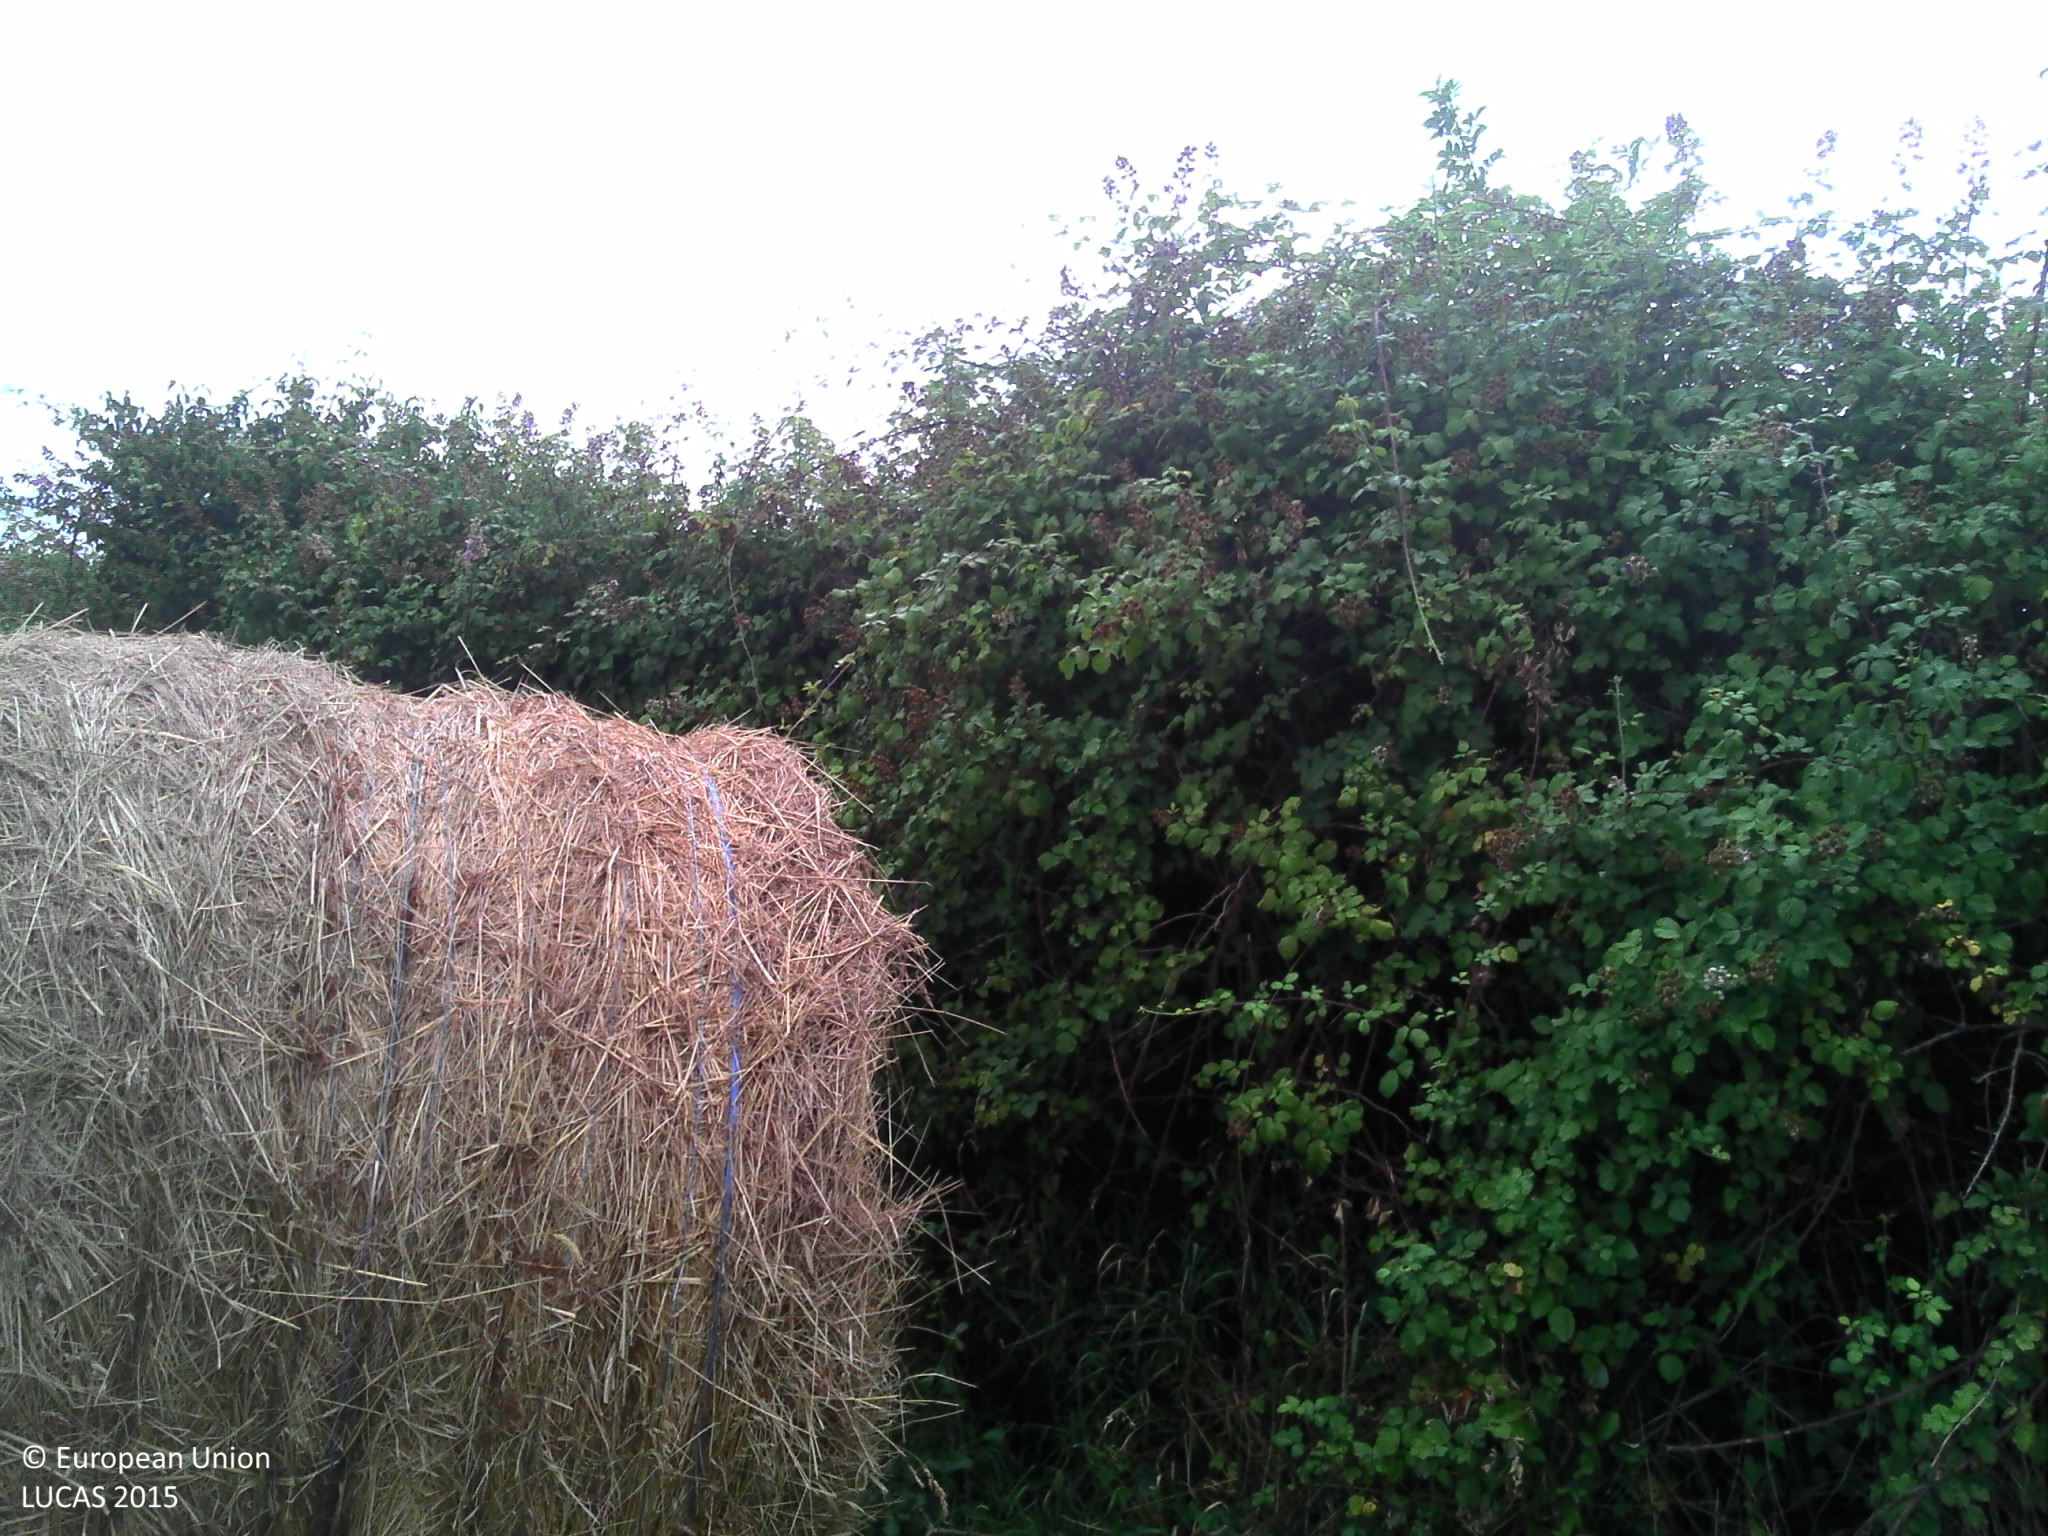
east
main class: Grassland
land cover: Grassland without tree/shrub cover
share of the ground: > 75 %
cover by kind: herbaceous plants 100 %
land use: Agriculture (excluding fallow land and kitchen gardens)
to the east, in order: Grassland without tree/shrub cover; Abandoned hedges; Fences; Grassland without tree/shrub cover; Fences; Grassland without tree/shrub cover; Fences; Shruby margins; Ditches and canals; Grass margins; Paved roads, cycling and walking lanes; Grass margins; Ditches and canals; Grass margins; Sunflower; Grassland without tree/shrub cover
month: July
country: FR
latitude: 47.2311
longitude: 0.4828
